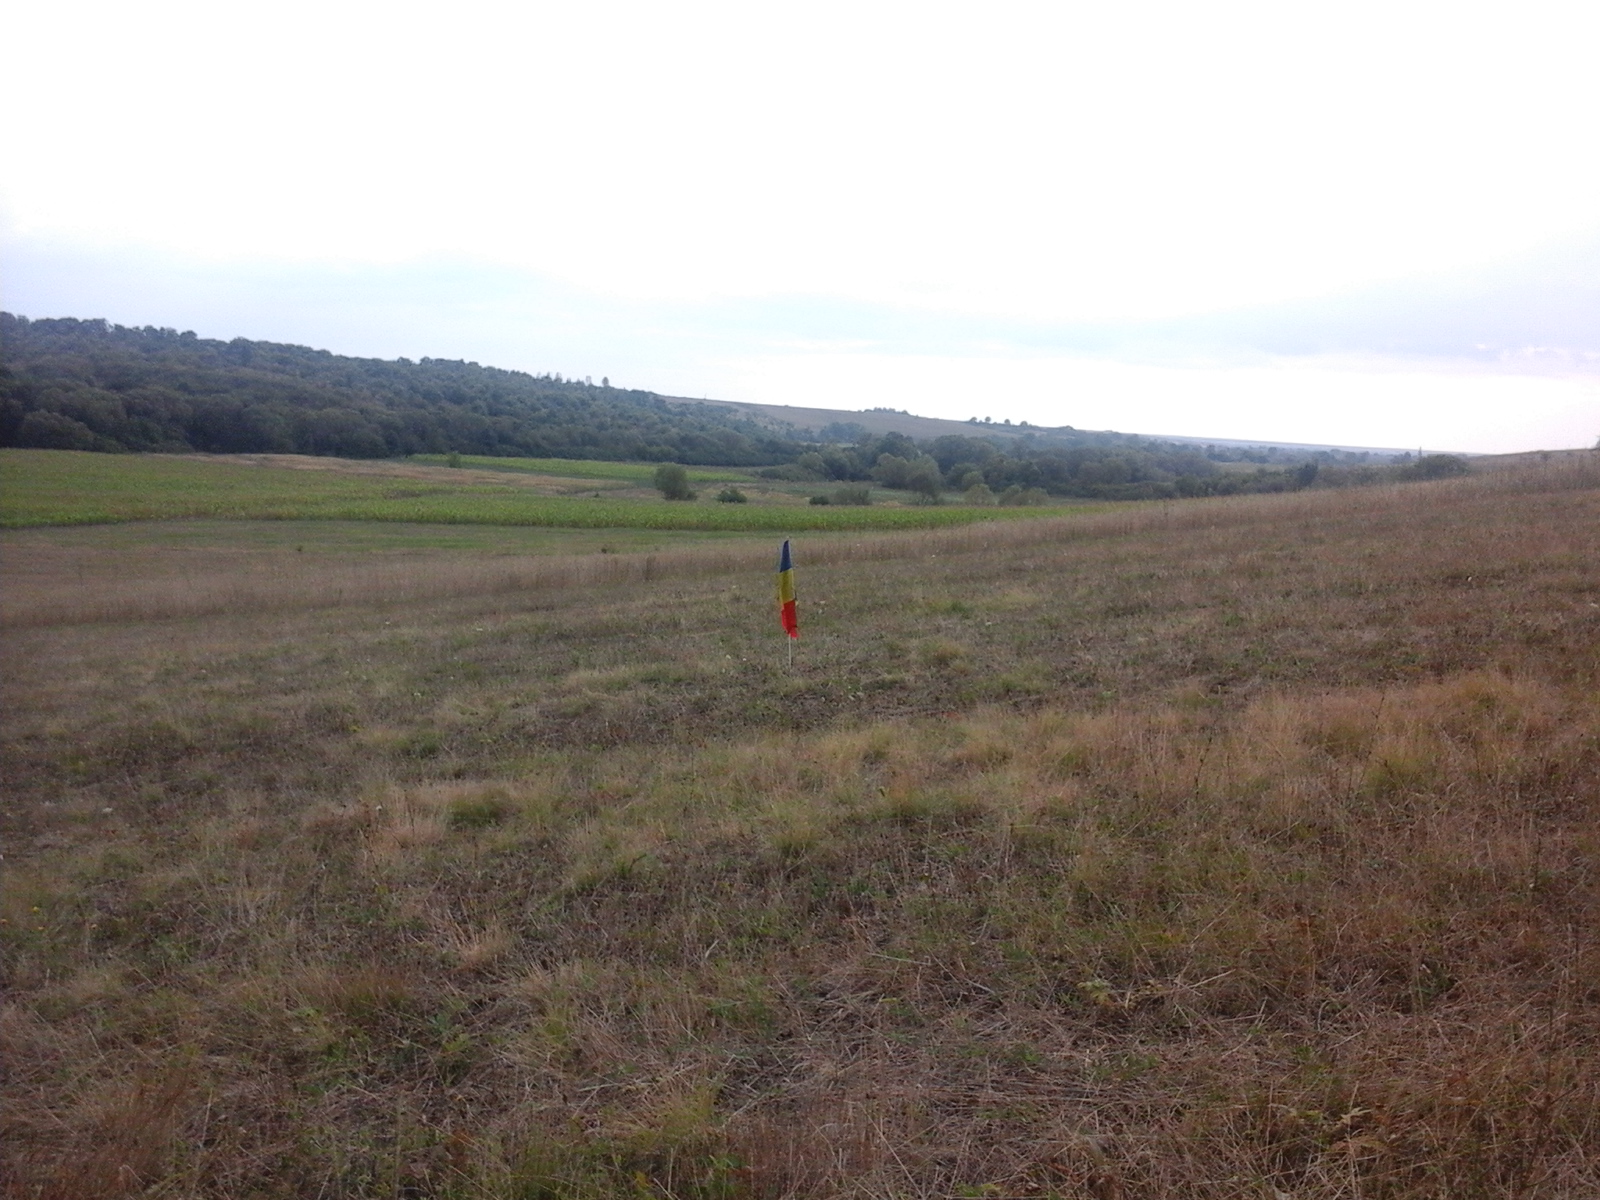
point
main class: Grassland
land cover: Grassland without tree/shrub cover
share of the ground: > 75 %
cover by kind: herbaceous plants 100 %
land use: Agriculture (excluding fallow land and kitchen gardens)
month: August
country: RO
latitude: 45.5511
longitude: 21.6264
